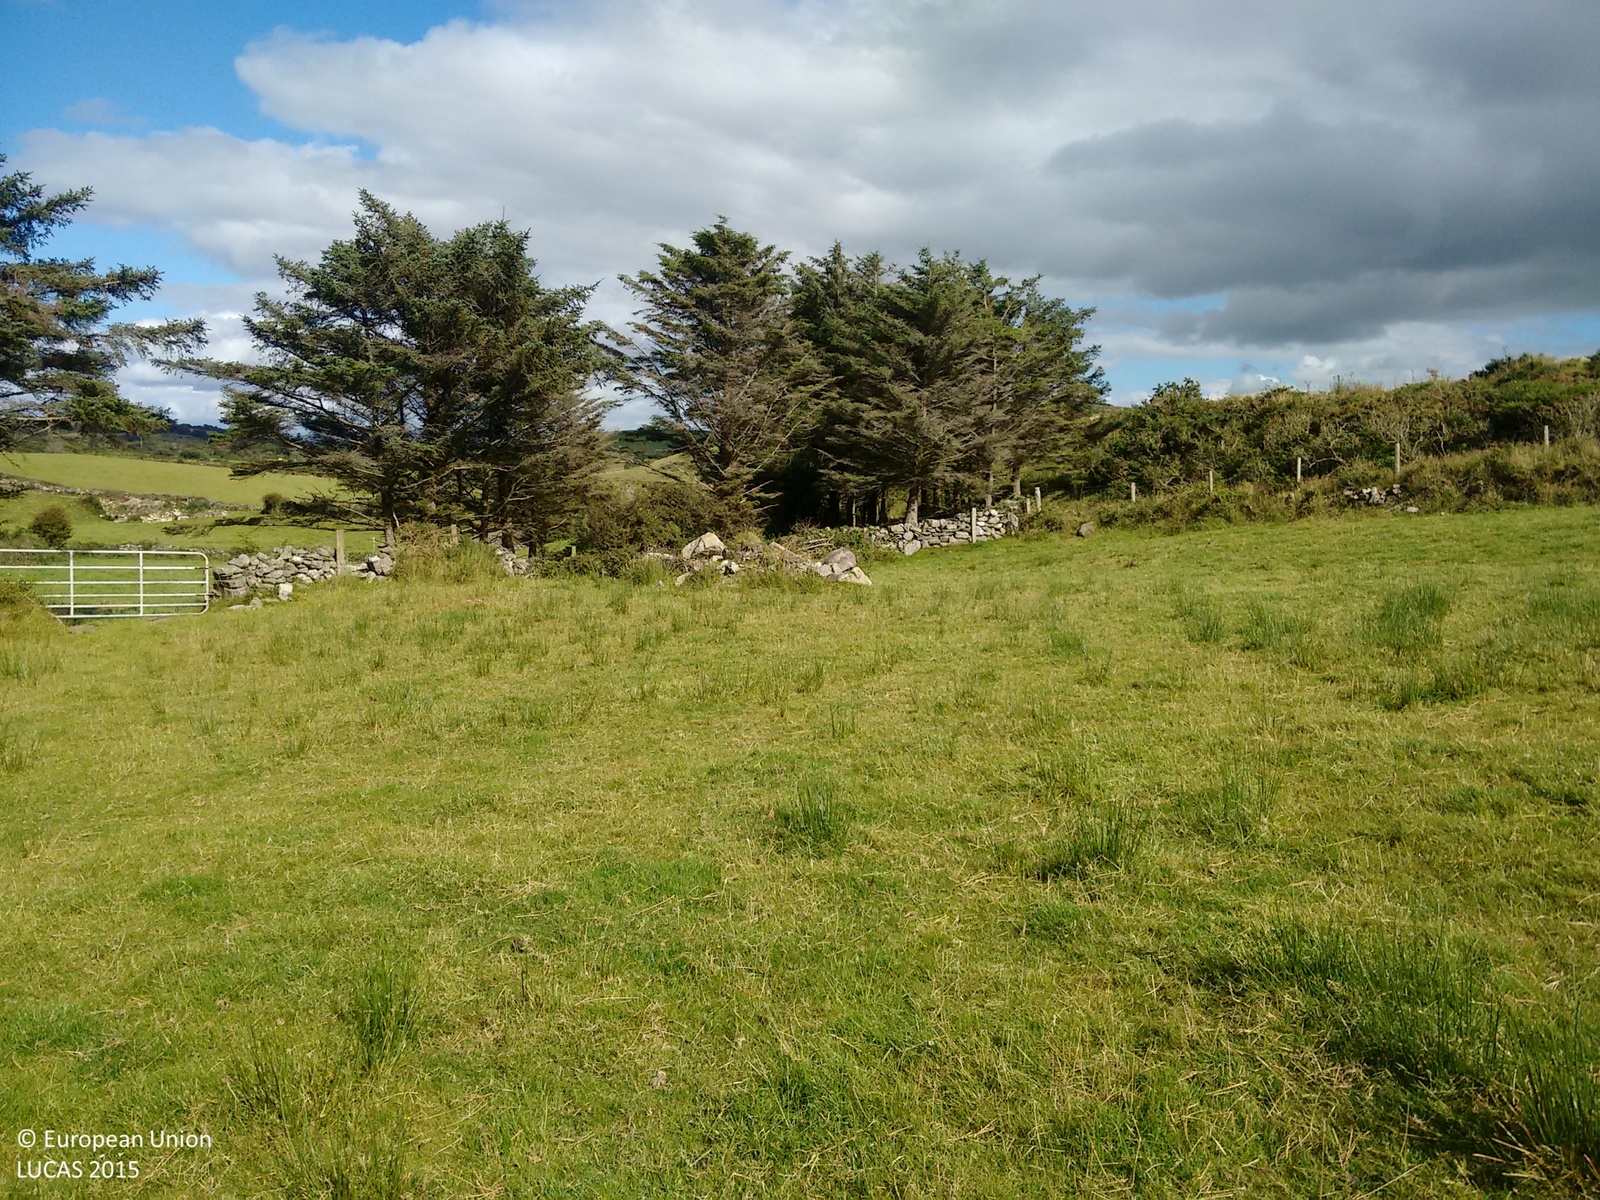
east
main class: Grassland
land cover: Grassland without tree/shrub cover
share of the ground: > 75 %
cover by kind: herbaceous plants 100 %
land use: Agriculture (excluding fallow land and kitchen gardens)
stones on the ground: < 10 %
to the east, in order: Grassland without tree/shrub cover; Fences; Dry stone walls; Lines of trees; Grassland without tree/shrub cover; Dry stone walls; Abandoned hedges; Grassland without tree/shrub cover; Tracks; Grassland without tree/shrub cover; Fences; Abandoned hedges; Shrubland with sparse tree cover; Rocks and stones; Intertidal flats
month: August
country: IE
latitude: 51.7186
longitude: -9.4990
